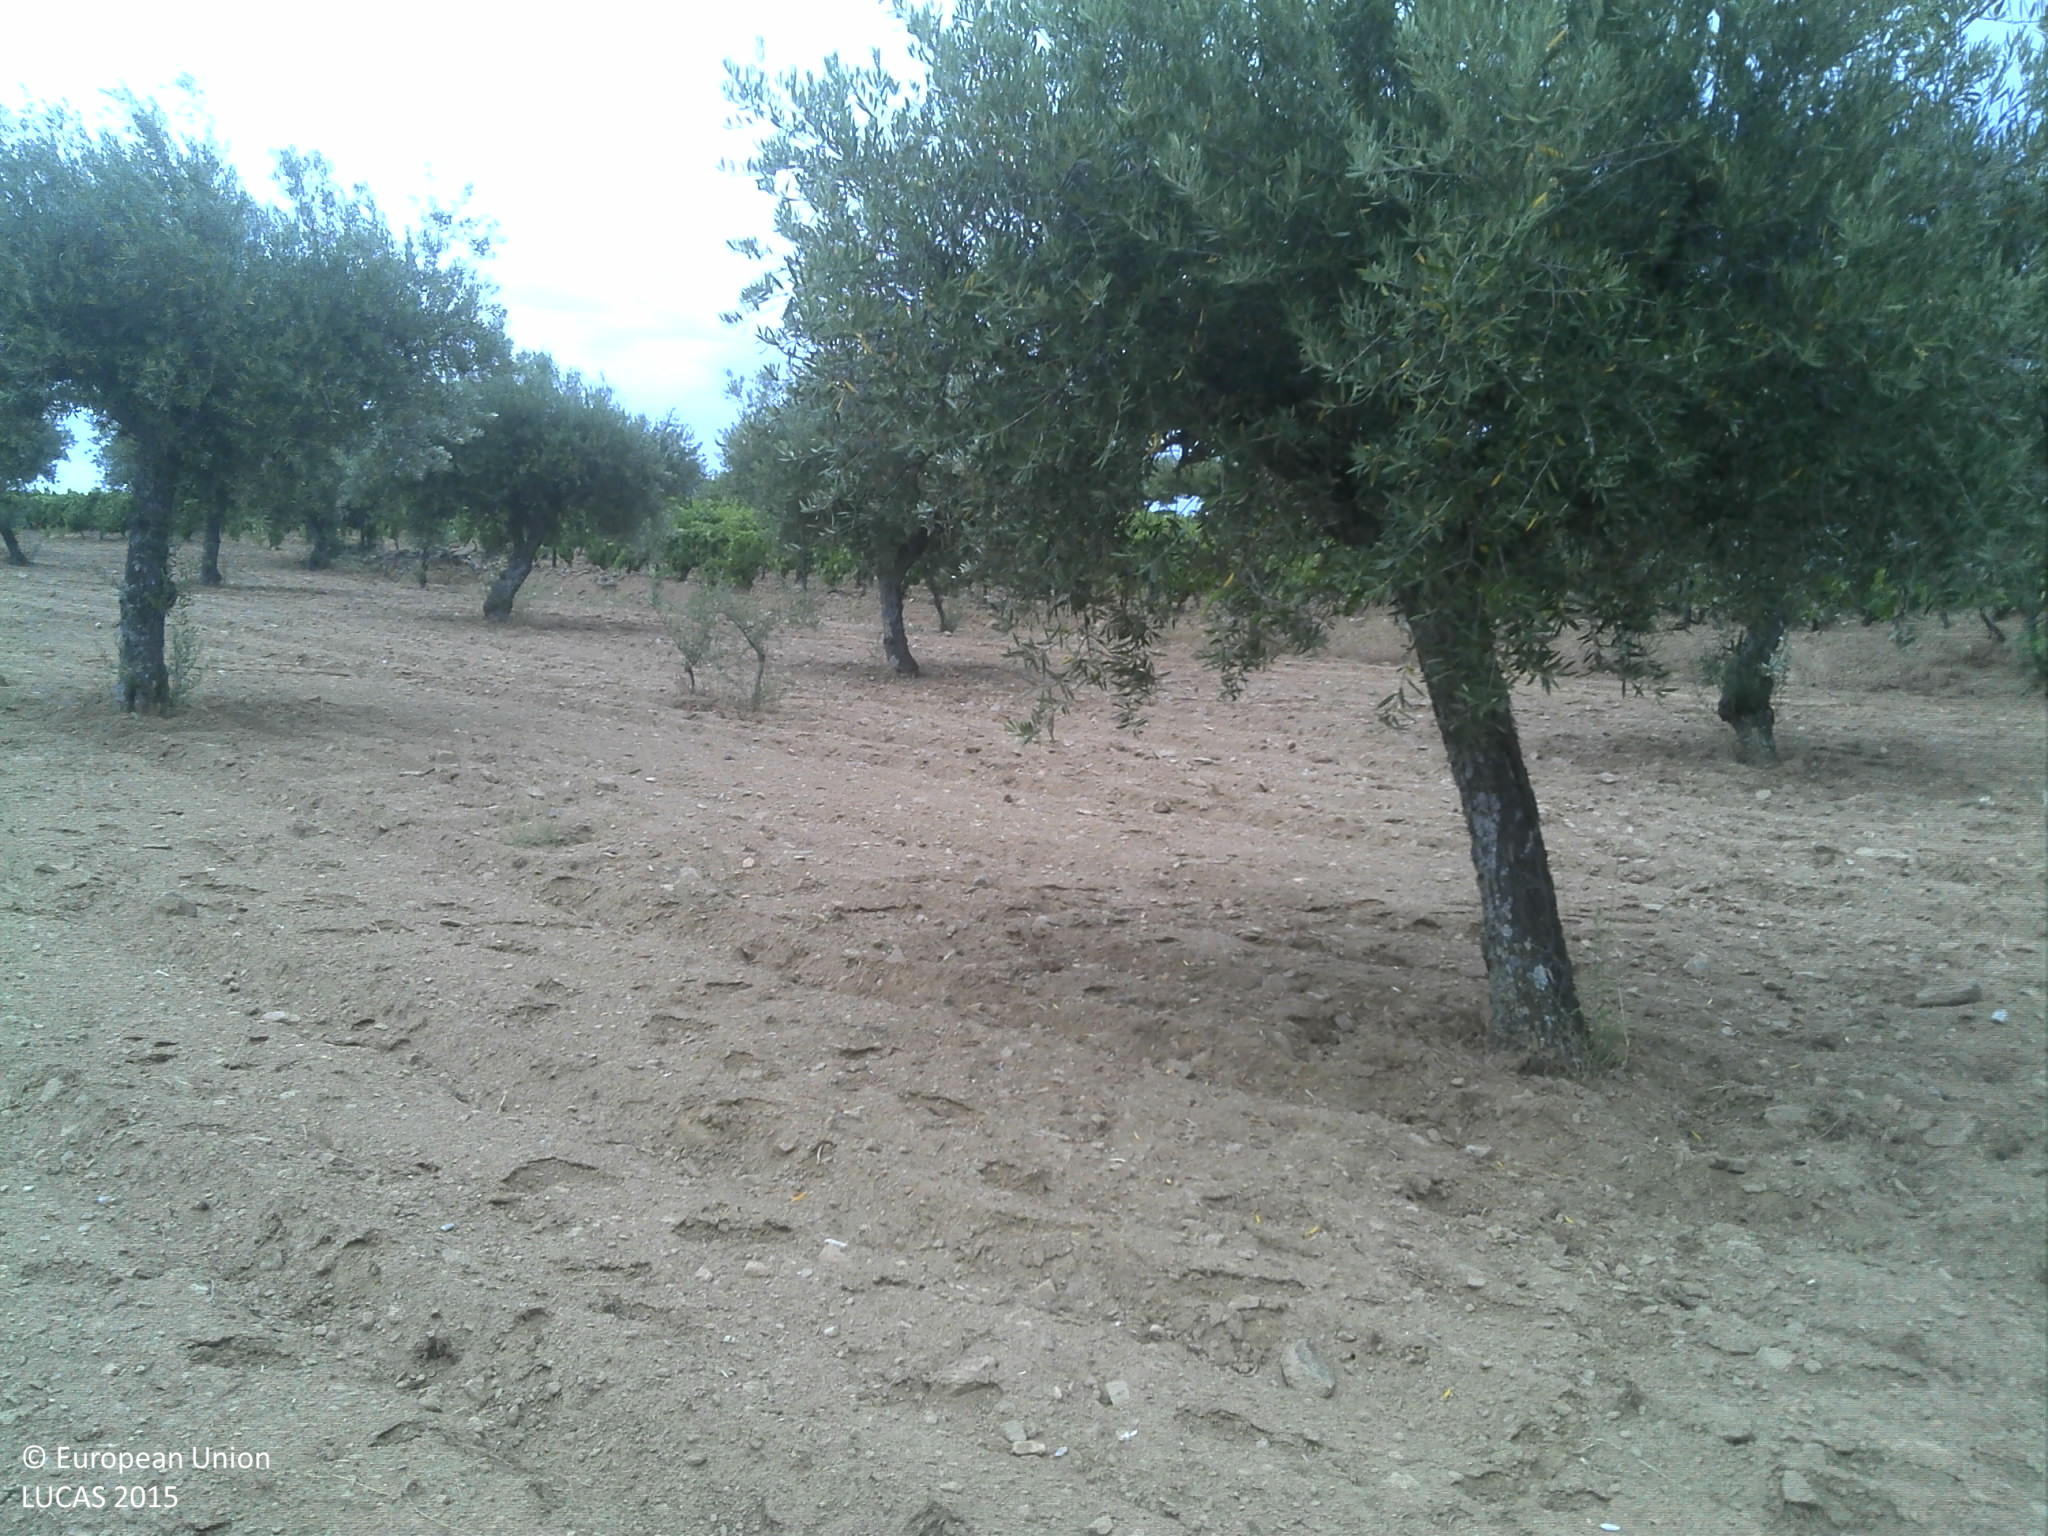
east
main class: Cropland
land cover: Olive groves
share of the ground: < 10 %
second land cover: Other bare soil
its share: > 75 %
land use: Agriculture (excluding fallow land and kitchen gardens)
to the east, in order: Olive groves; Other bare soil; Vineyards; Nuts trees; Olive groves; Tracks; Vineyards; Tracks; Dry stone walls; Olive groves; Other bare soil; Vineyards; Other bare soil
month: July
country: PT
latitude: 41.0488
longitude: -7.2579
